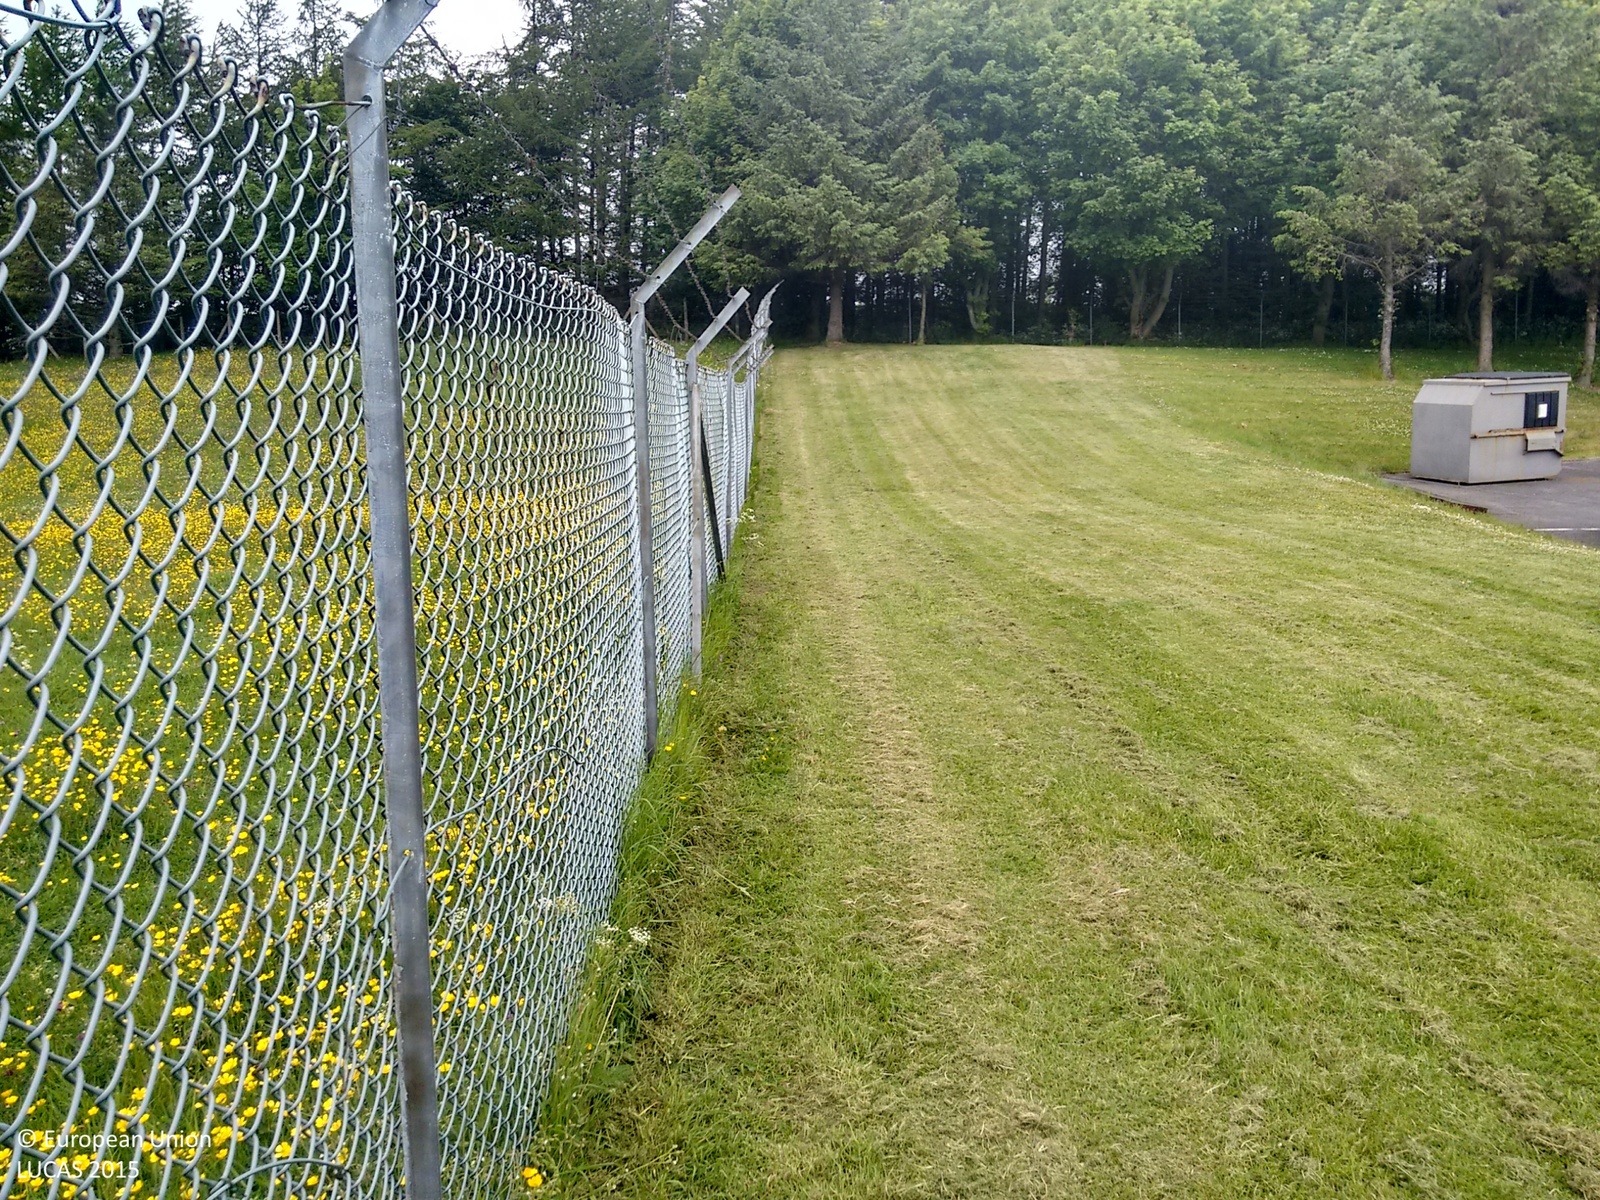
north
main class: Grassland
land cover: Grassland without tree/shrub cover
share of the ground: > 75 %
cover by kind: herbaceous plants 100 %
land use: Agriculture (excluding fallow land and kitchen gardens)
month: June
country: GB
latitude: 54.8577
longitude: -1.8134
